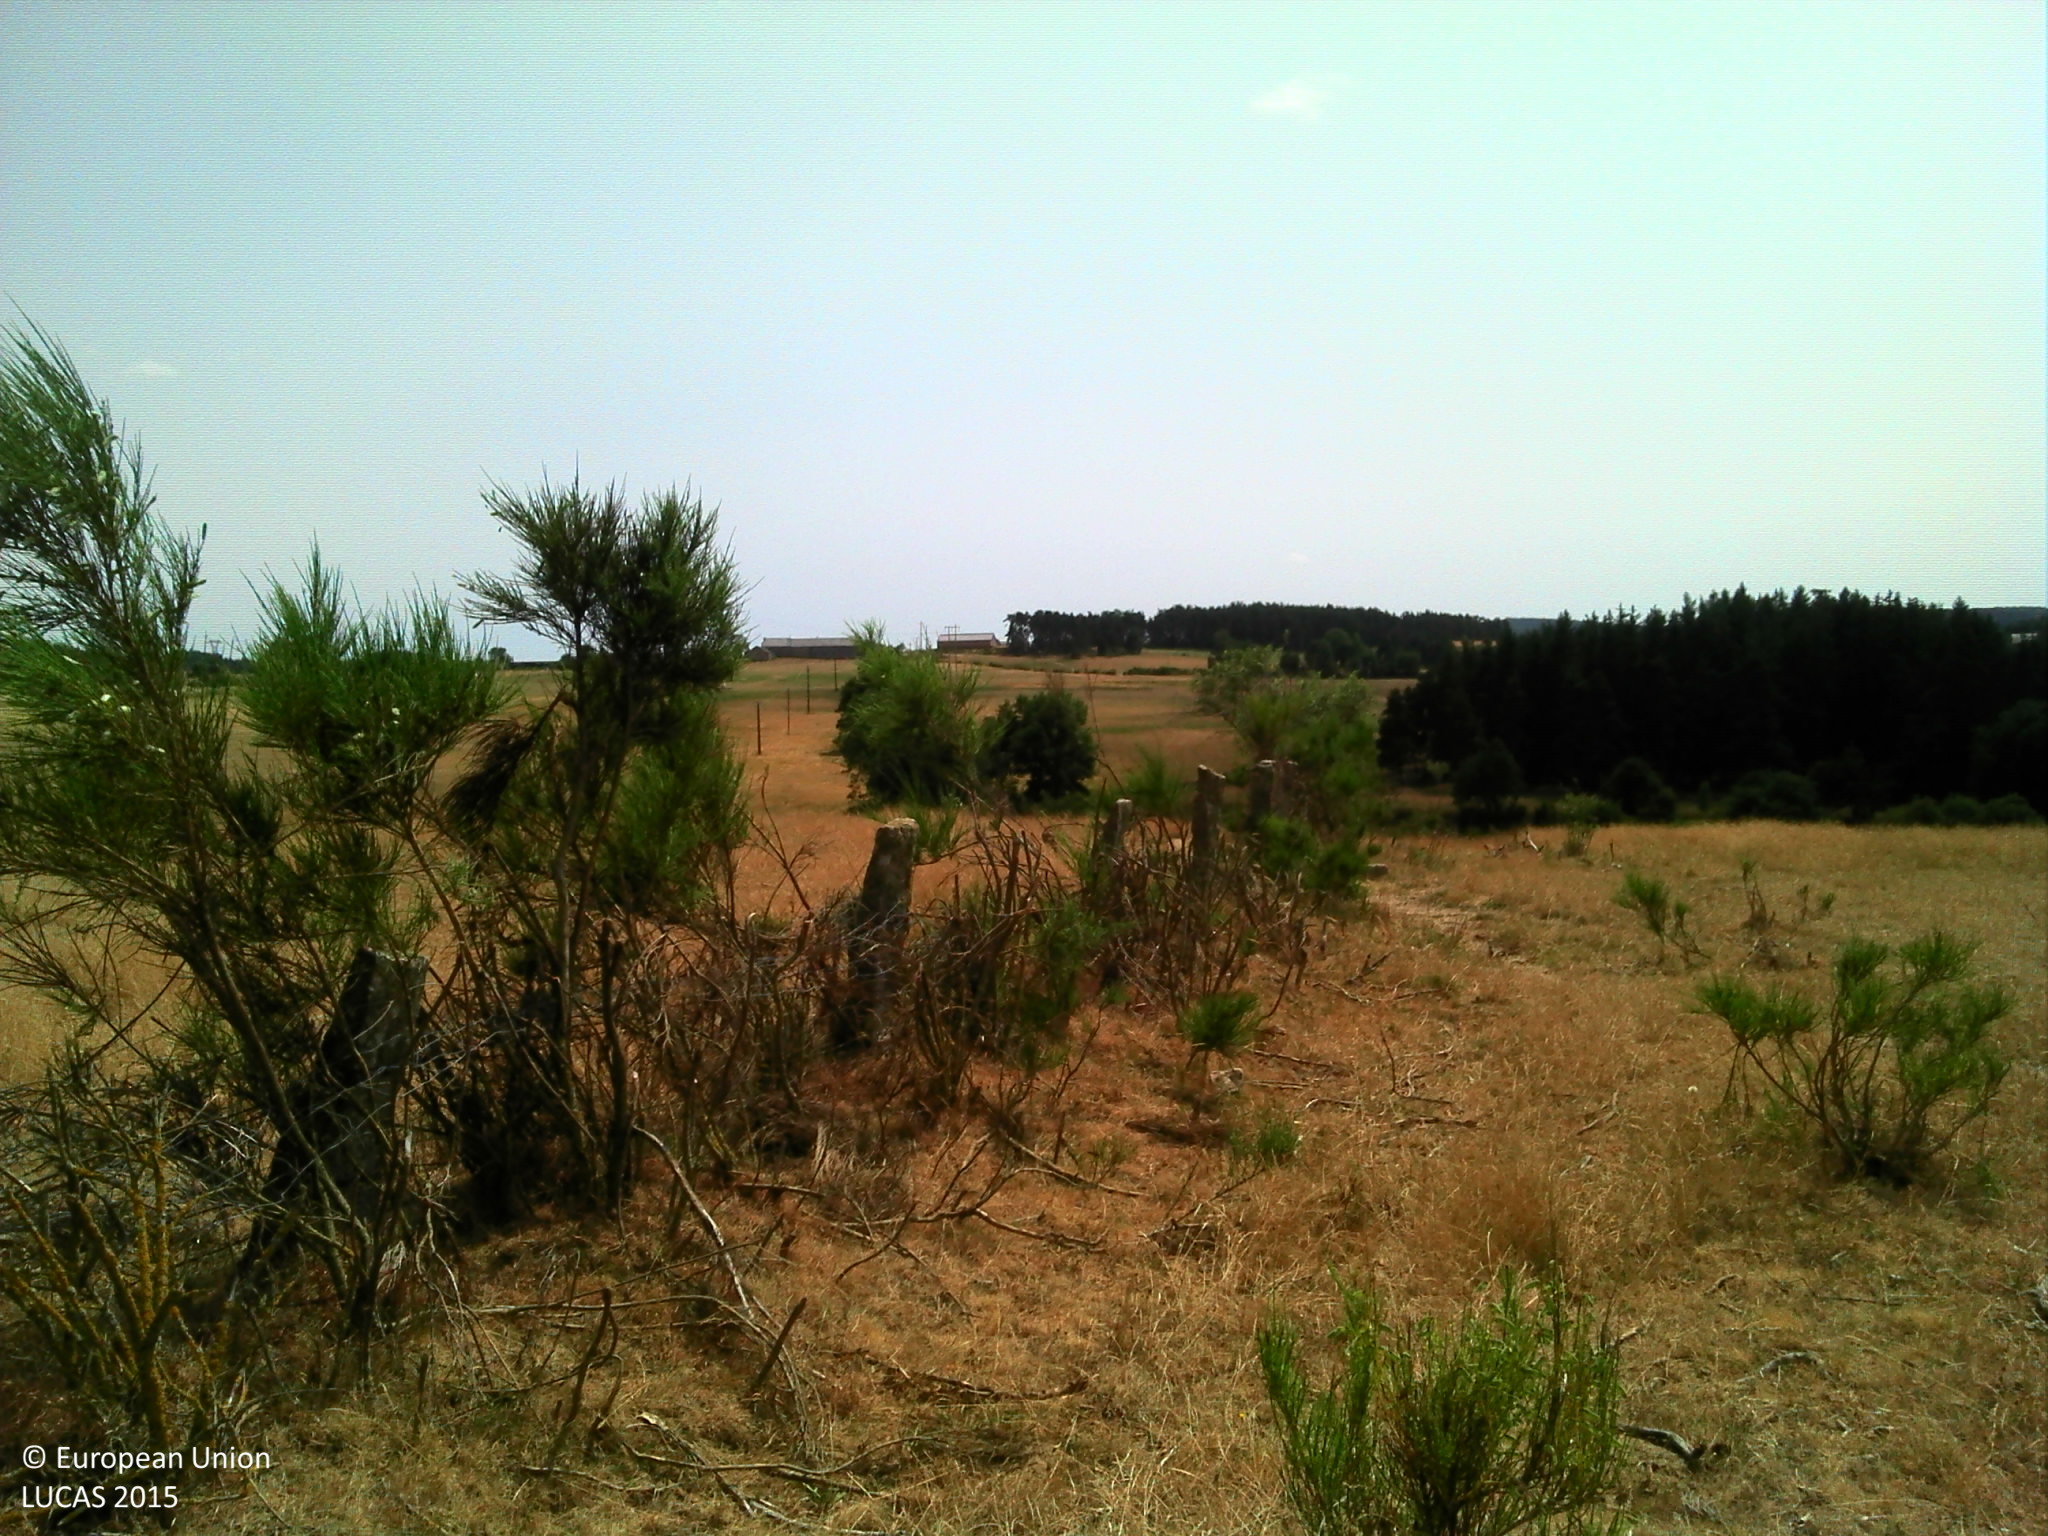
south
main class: Grassland
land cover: Grassland without tree/shrub cover
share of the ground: > 75 %
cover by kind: herbaceous plants 100 %
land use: Agriculture (excluding fallow land and kitchen gardens)
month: July
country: FR
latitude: 44.9071
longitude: 3.2271
